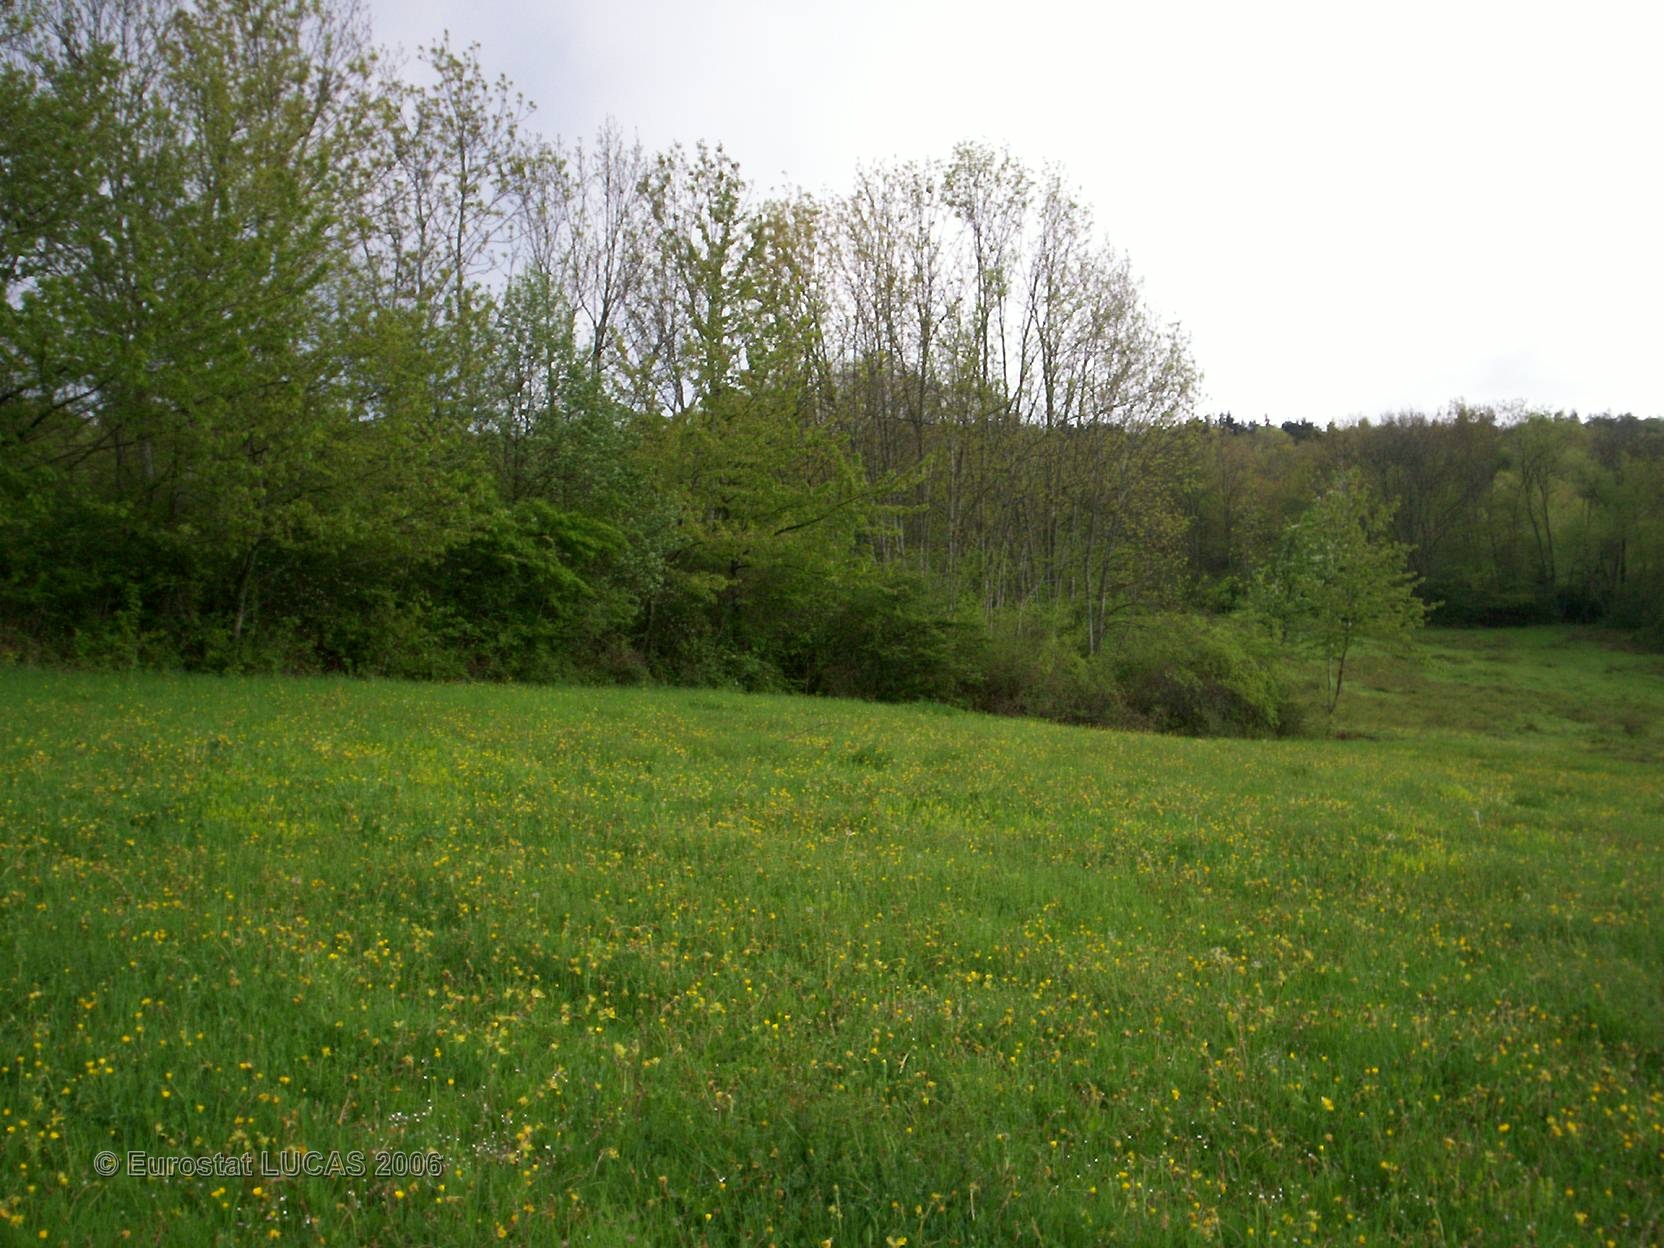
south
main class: Grassland
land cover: Grassland without tree/shrub cover
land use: Agriculture (excluding fallow land and kitchen gardens)
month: May
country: FR
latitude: 45.5299
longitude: 3.0733
